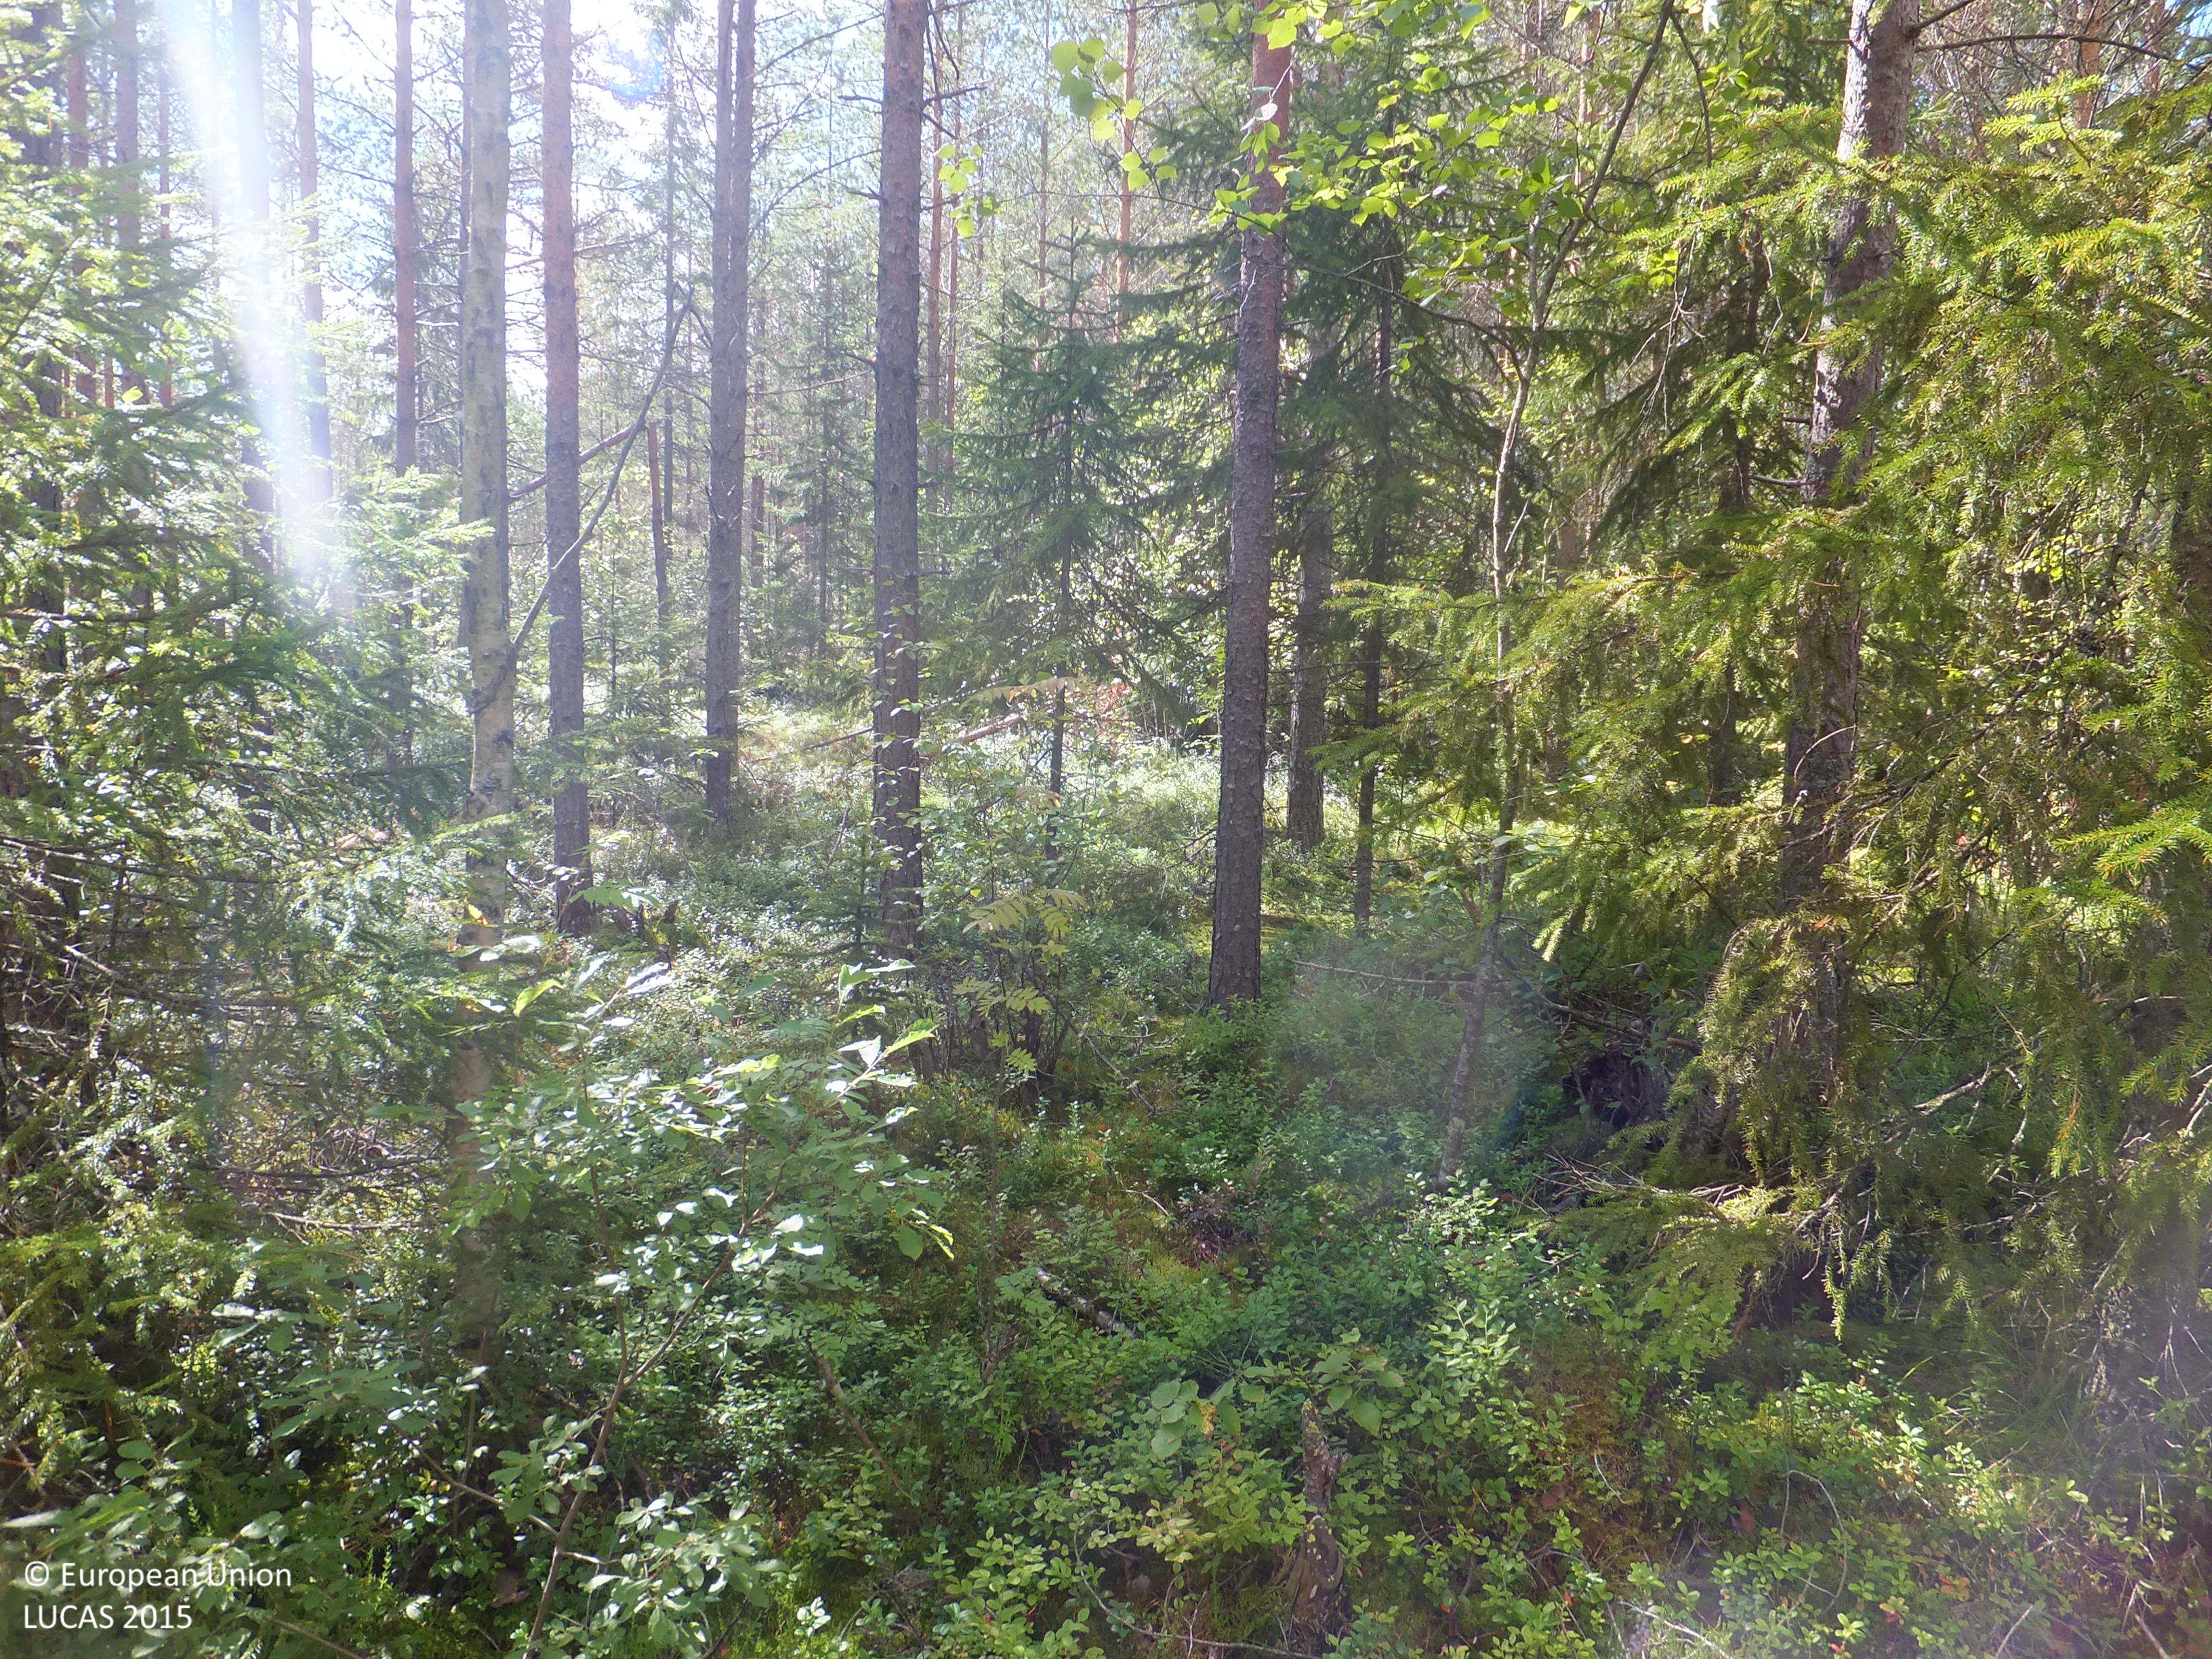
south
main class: Woodland
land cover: Pine dominated coniferous woodland
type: boreal forest
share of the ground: > 75 %
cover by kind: coniferous forest trees 75 %, shrubs 10 %, lichens and mosses 10 %, broadleaved forest trees 5 %
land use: Forestry
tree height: > 5 m
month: August
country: FI
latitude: 63.2645
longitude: 23.1082
